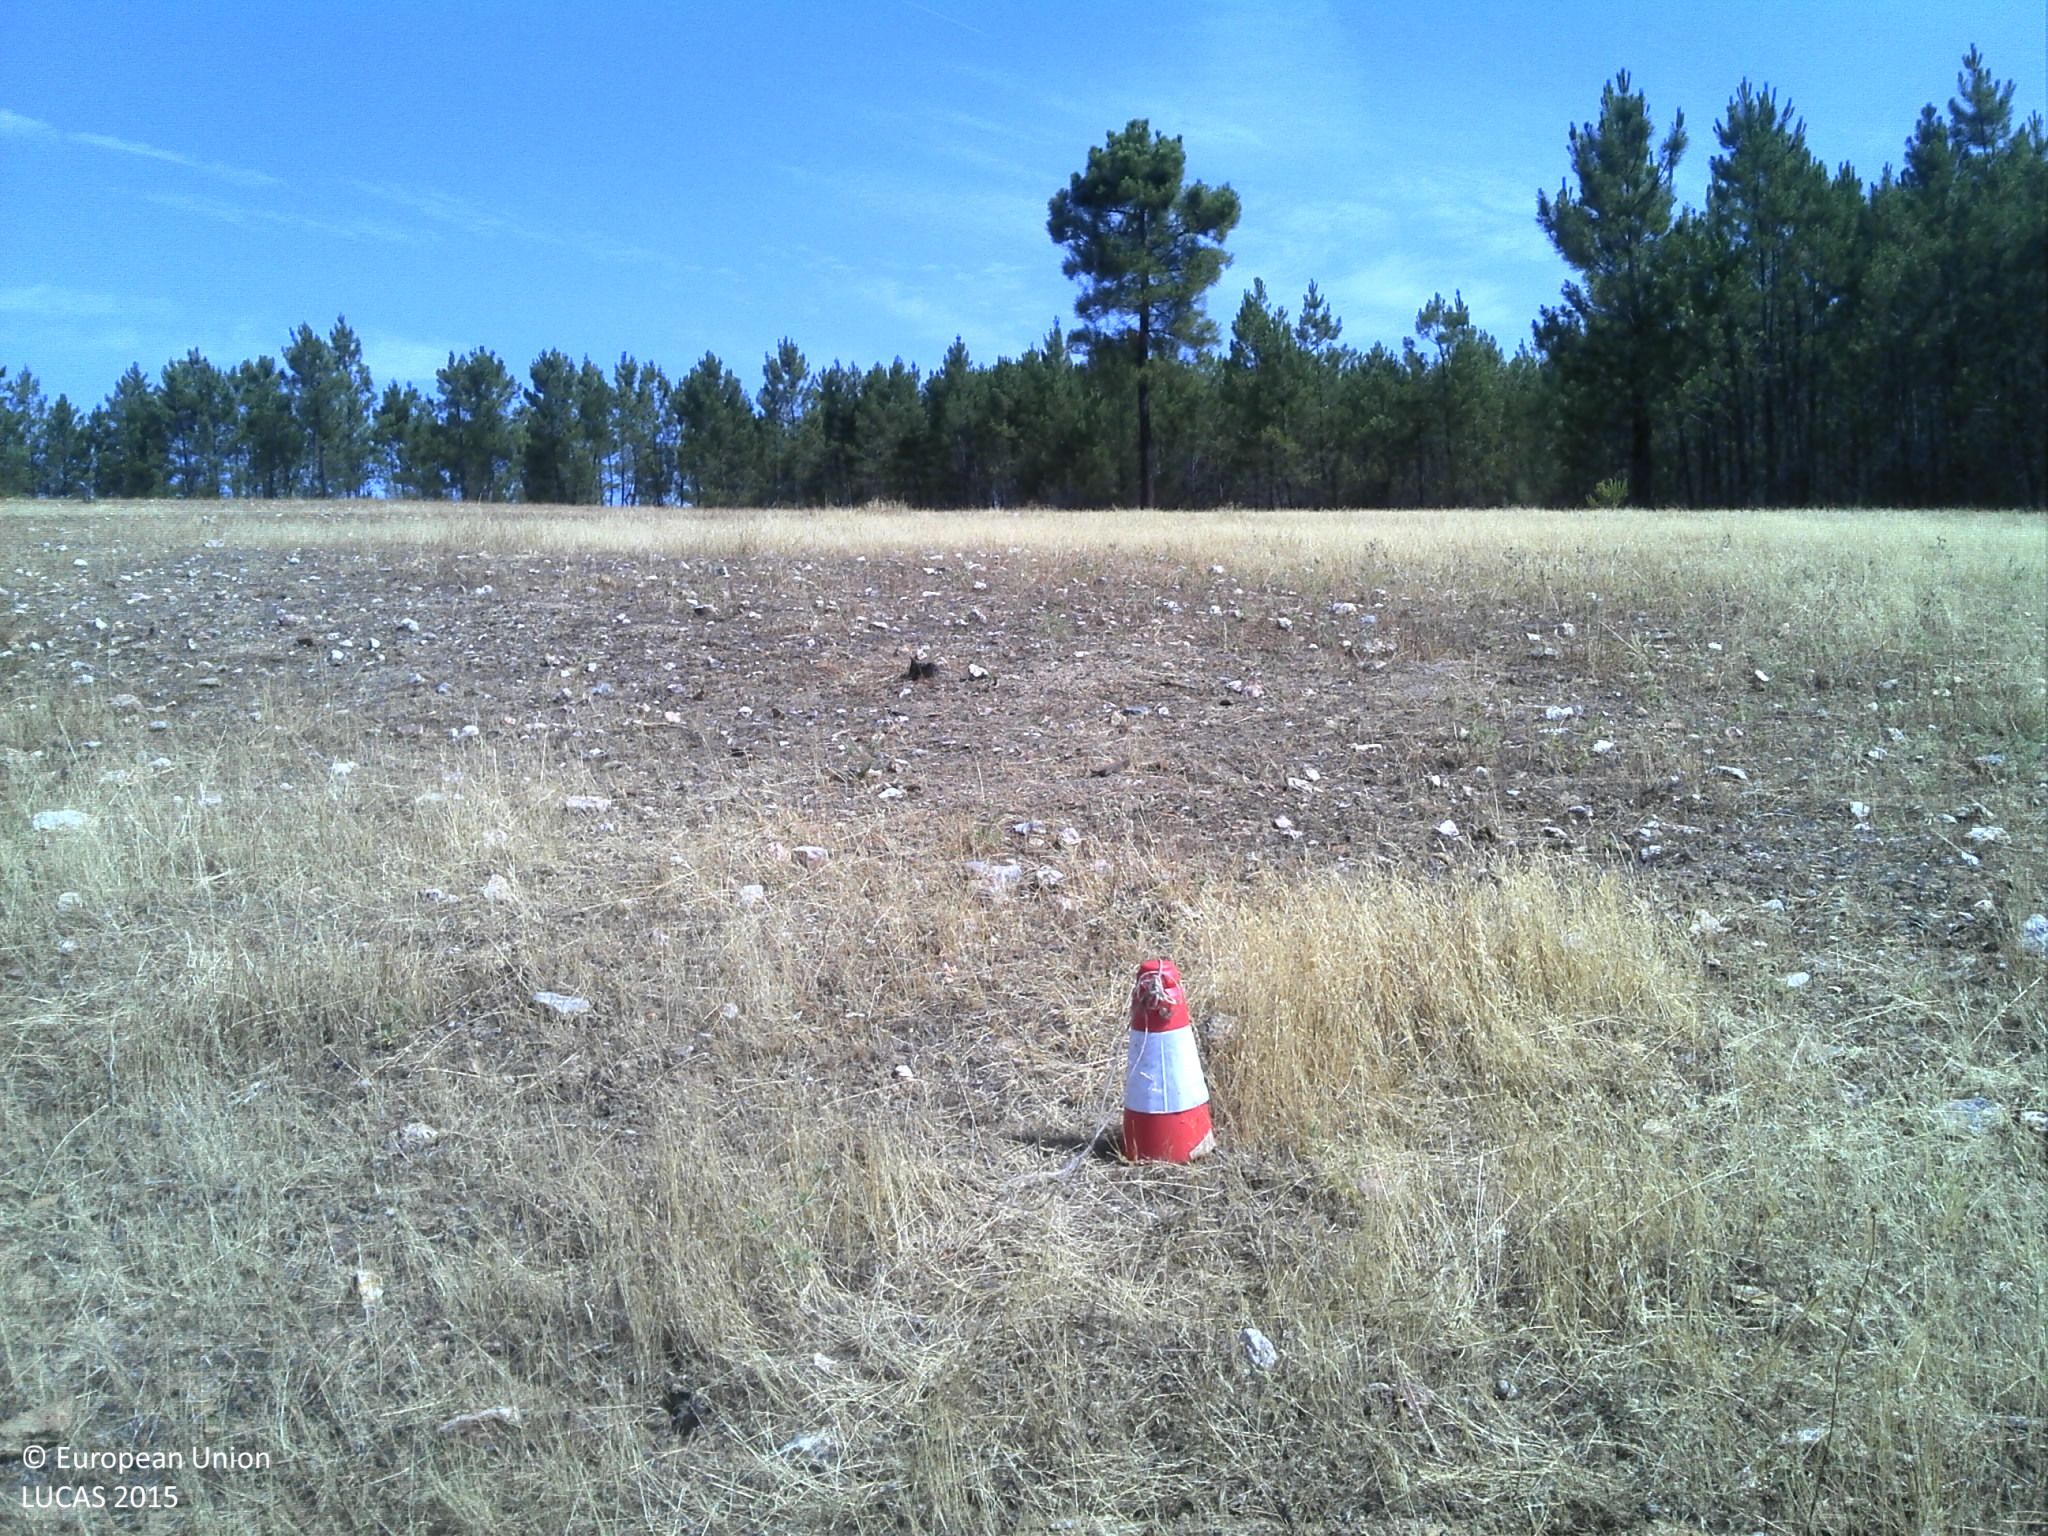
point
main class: Grassland
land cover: Grassland without tree/shrub cover
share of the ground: 25 - 50 %
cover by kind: unconsolidated bare surface 75 %, herbaceous plants 25 %
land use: Agriculture (excluding fallow land and kitchen gardens)
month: July
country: PT
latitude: 39.7523
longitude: -7.5954
